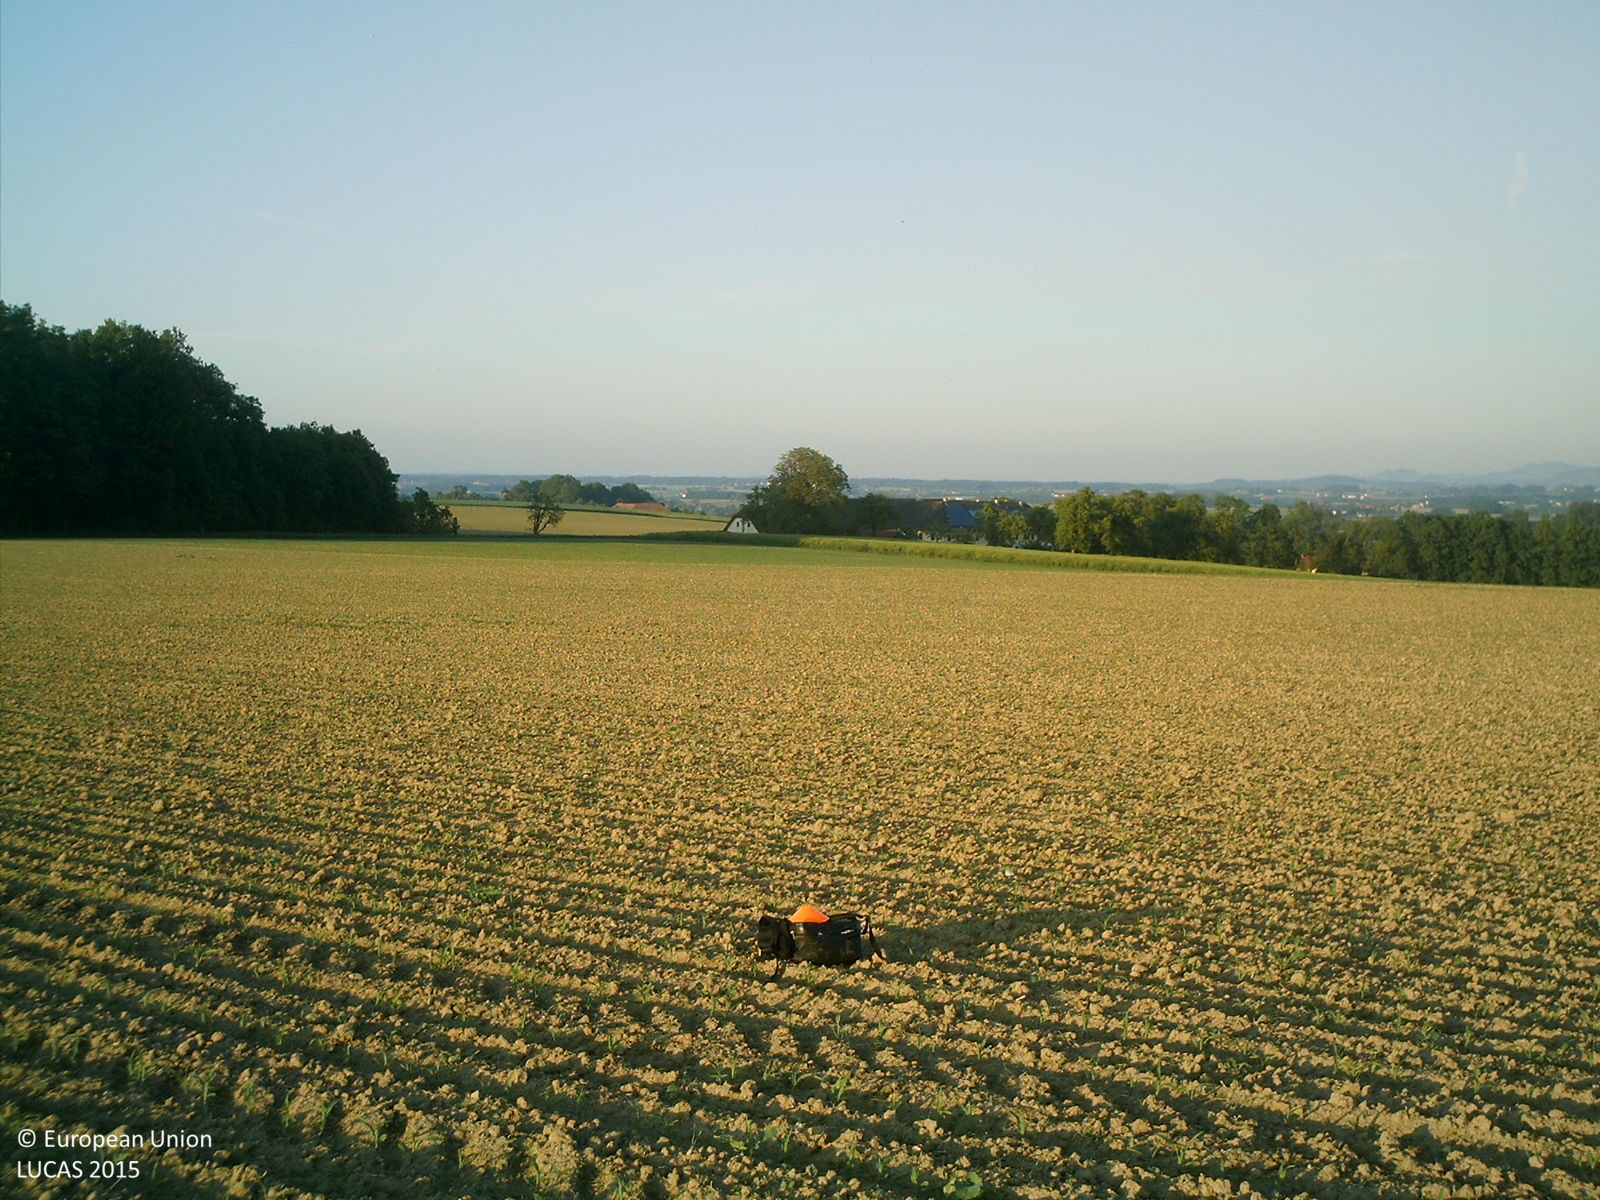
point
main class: Cropland
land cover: Maize
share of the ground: < 10 %
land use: Agriculture (excluding fallow land and kitchen gardens)
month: May
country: AT
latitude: 48.0006
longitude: 14.1678
